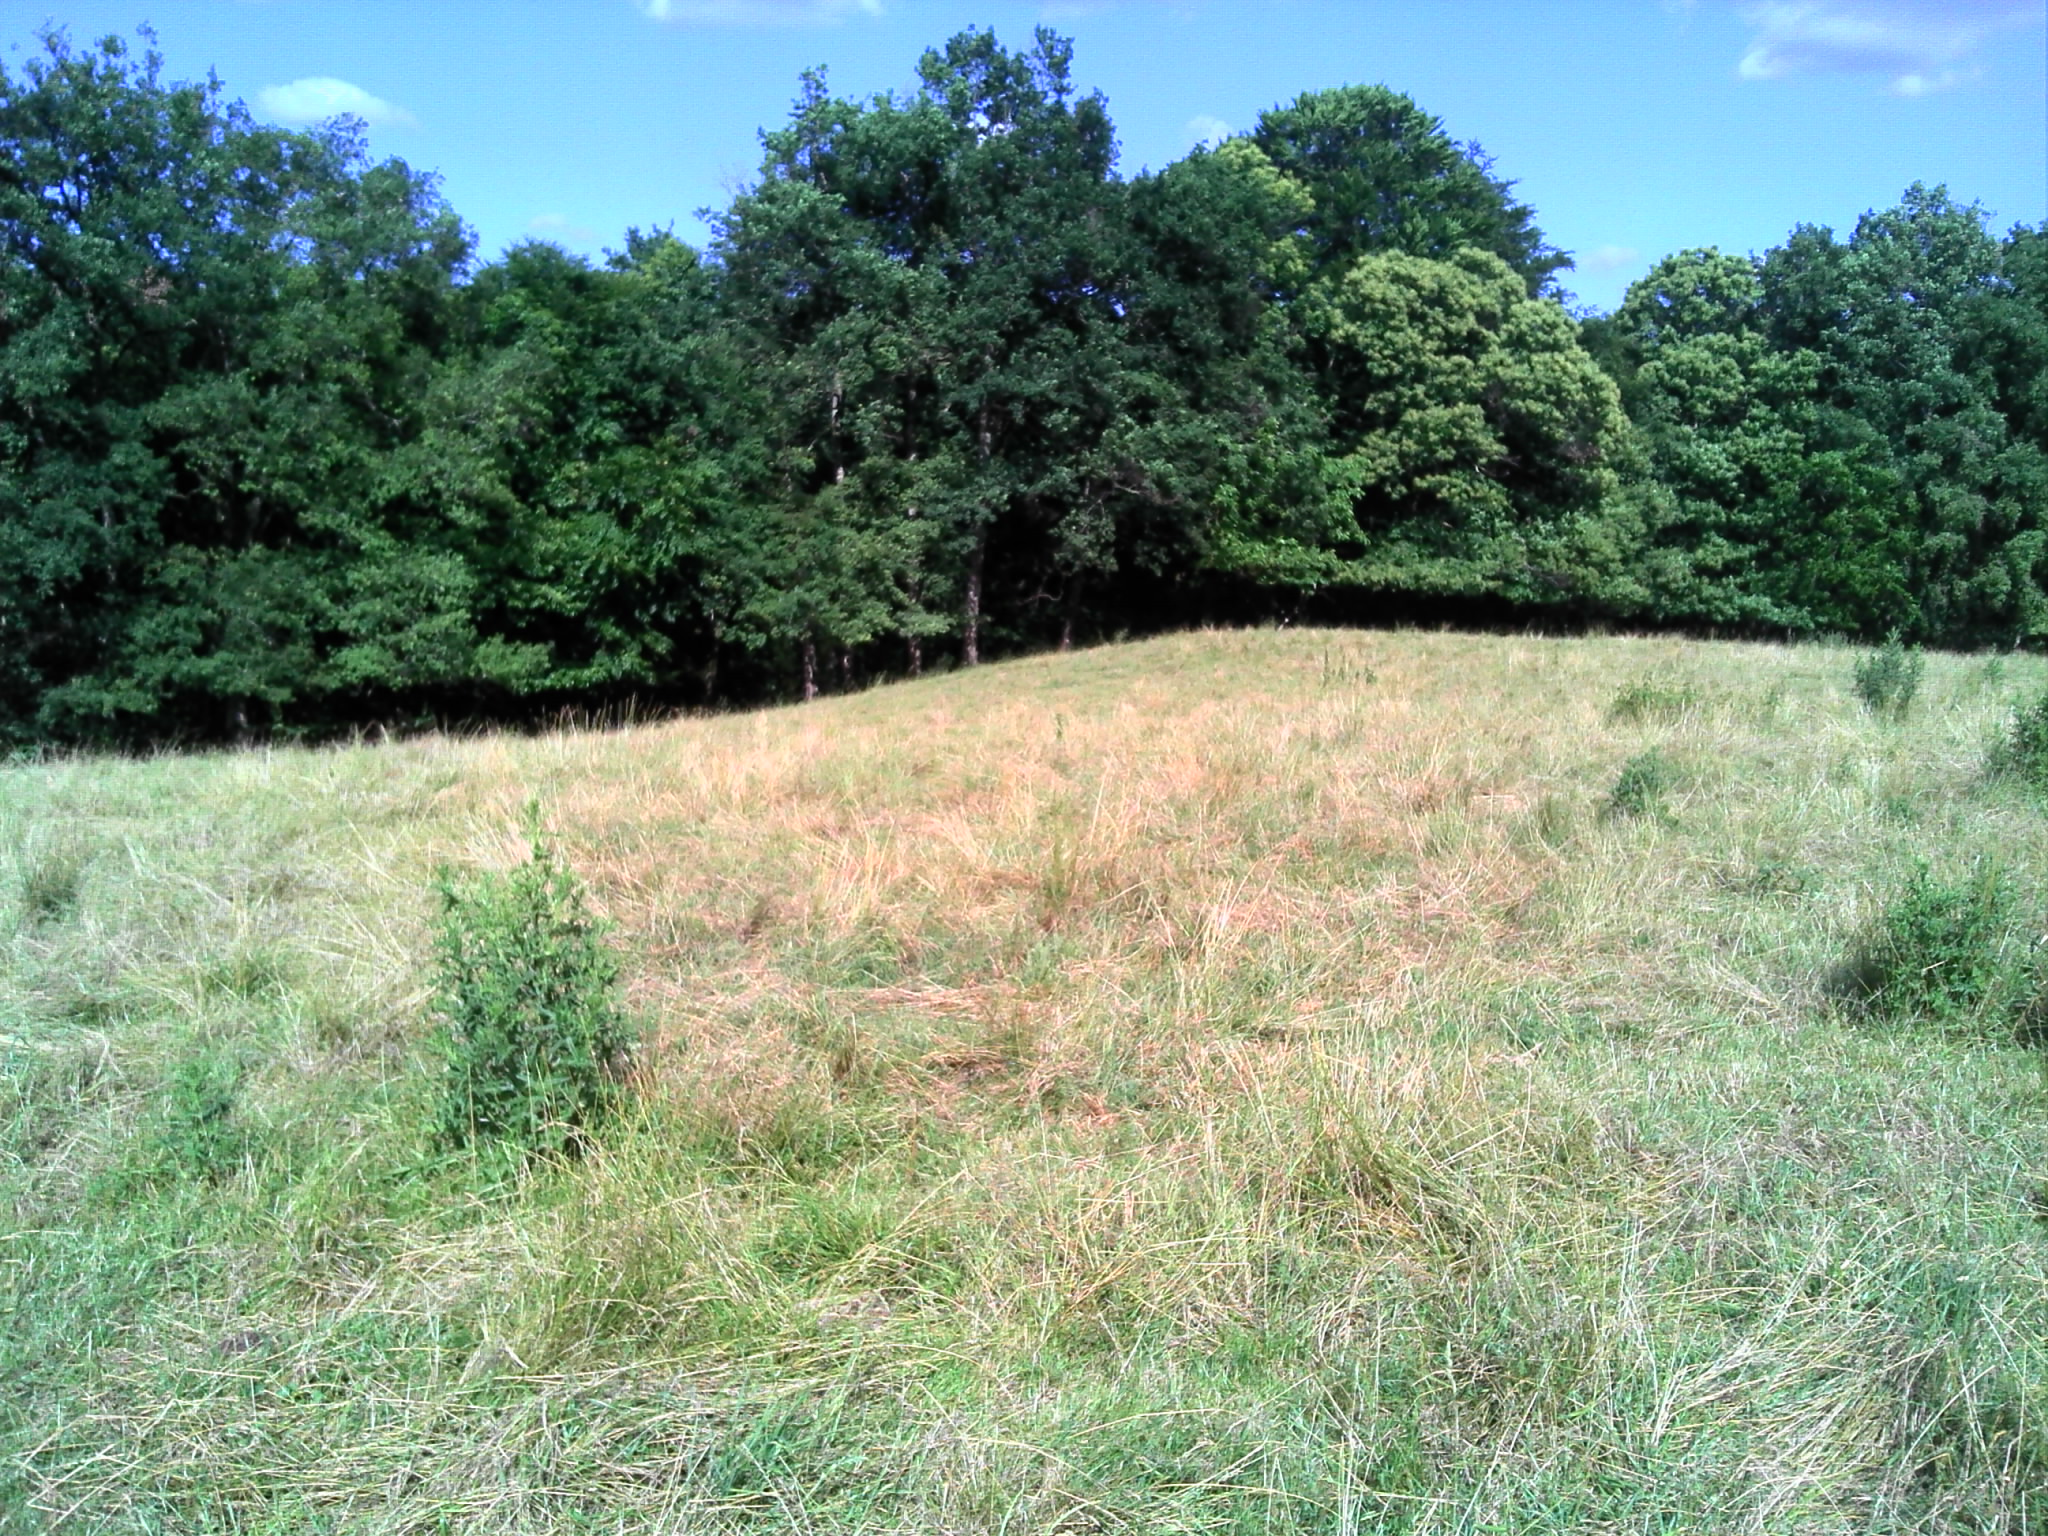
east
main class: Grassland
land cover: Grassland with sparse tree/shrub cover
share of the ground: > 75 %
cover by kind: herbaceous plants 95 %, broadleaved forest trees 5 %
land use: Agriculture (excluding fallow land and kitchen gardens)
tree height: > 5 m
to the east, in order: Grassland with sparse tree/shrub cover; Managed hedges; Broadleaved woodland; Rivers and streams; Broadleaved woodland
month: June
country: FR
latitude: 44.8895
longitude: 1.9585
